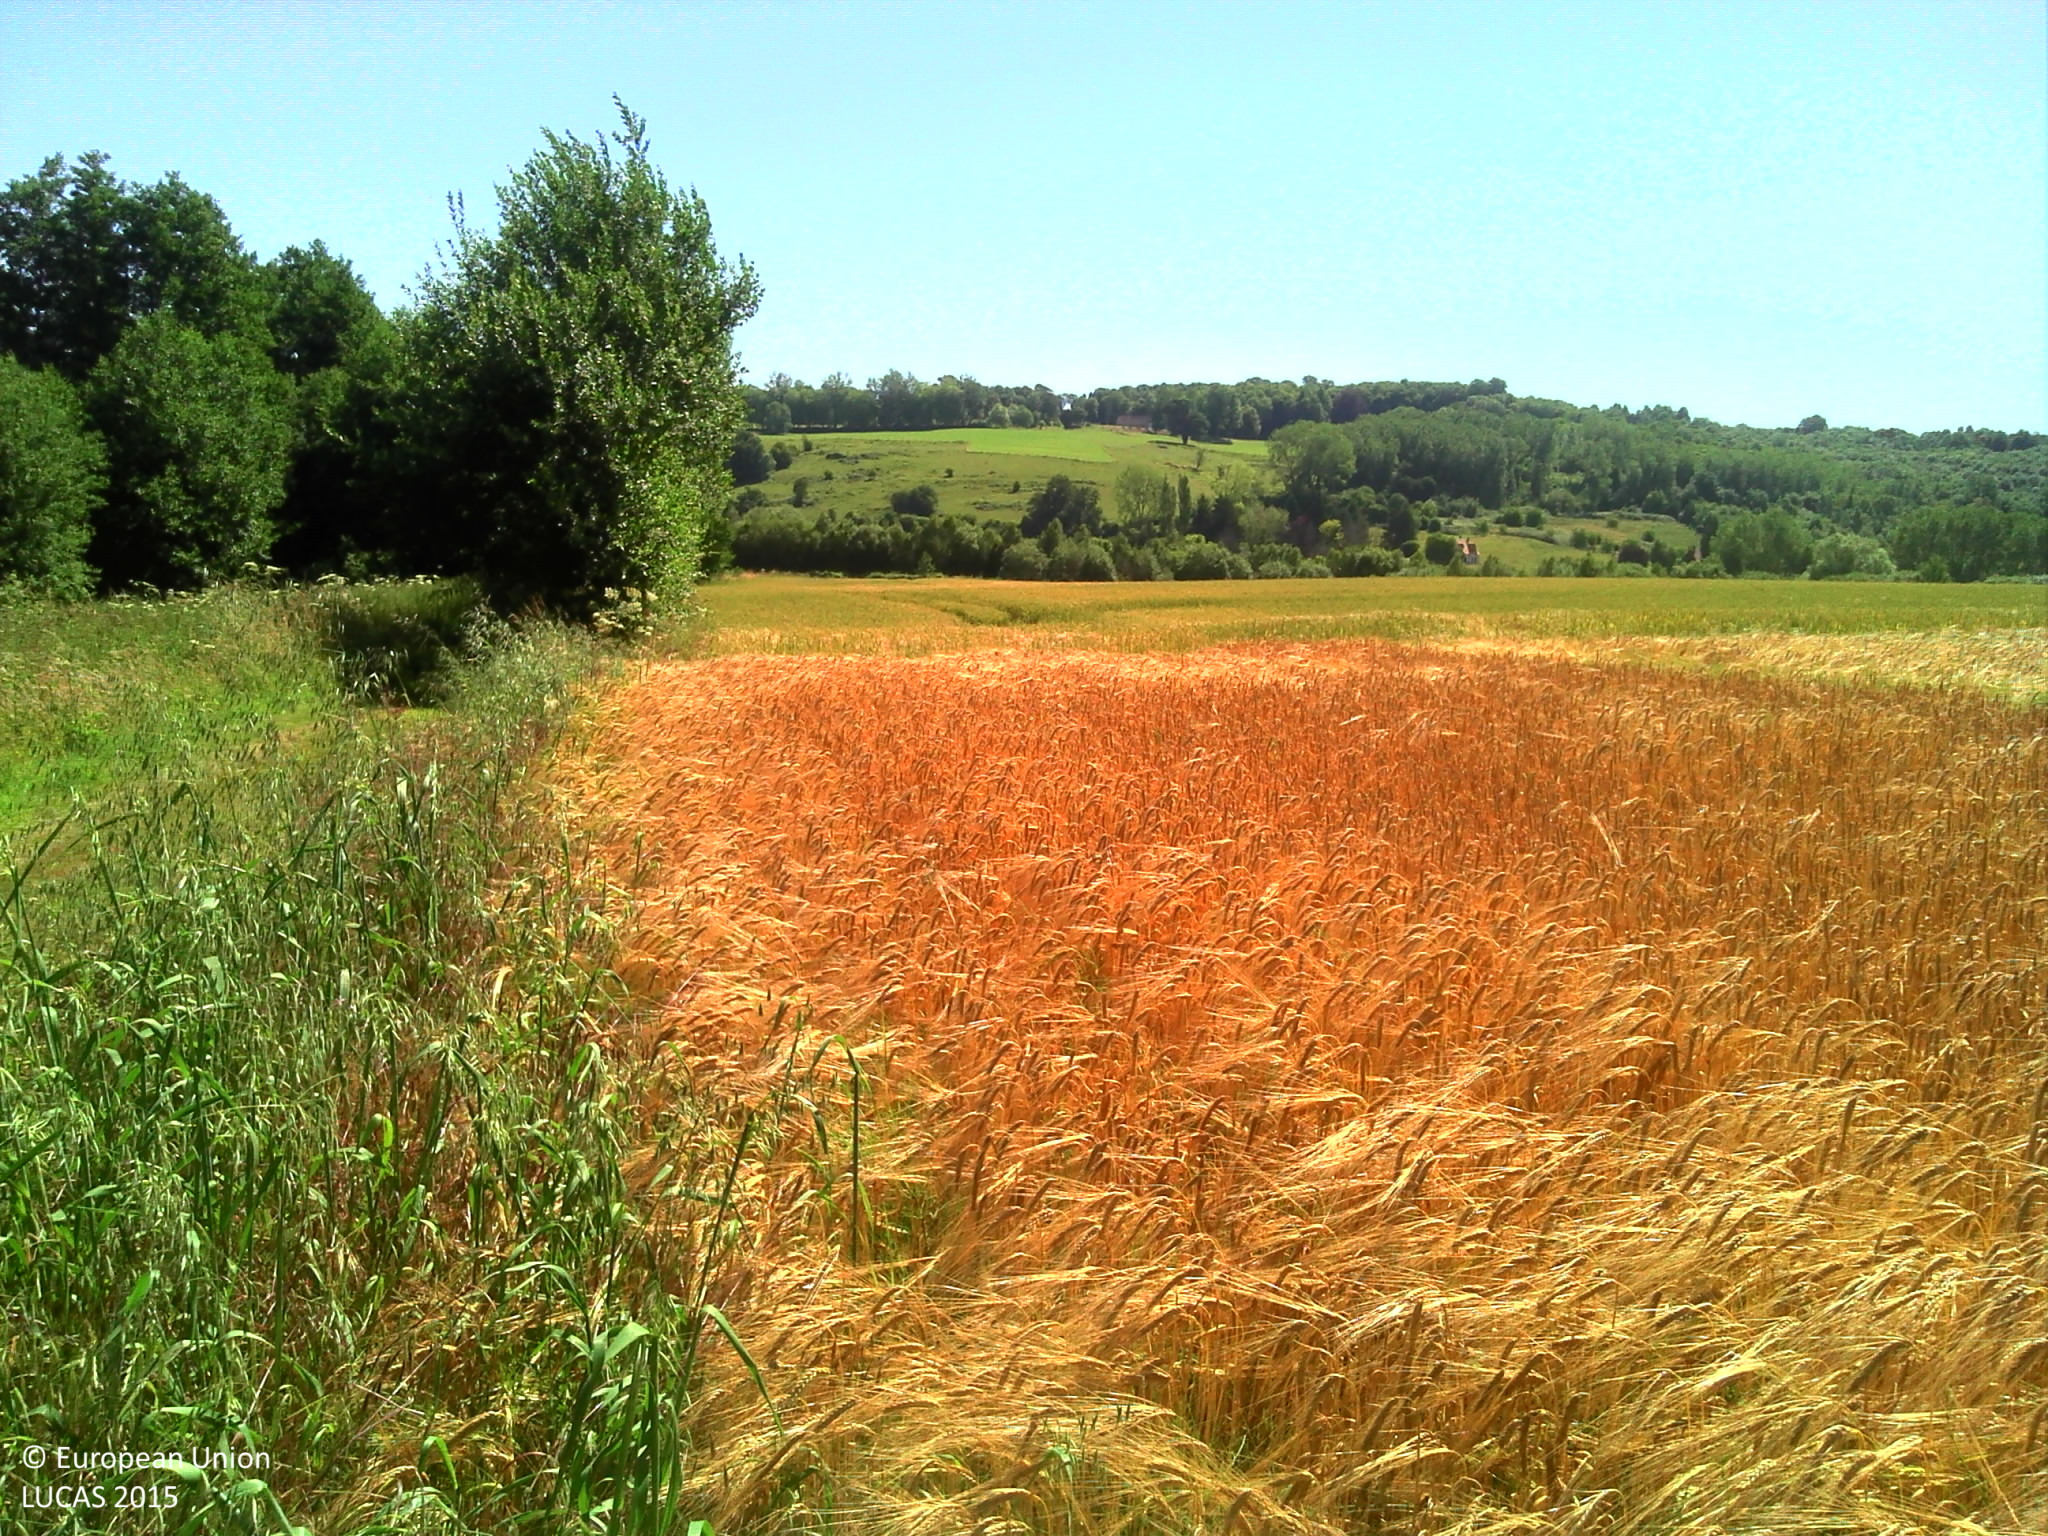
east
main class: Cropland
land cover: Barley
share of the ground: > 75 %
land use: Agriculture (excluding fallow land and kitchen gardens)
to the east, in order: Barley; Common wheat
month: June
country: FR
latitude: 48.9952
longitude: 0.1438
